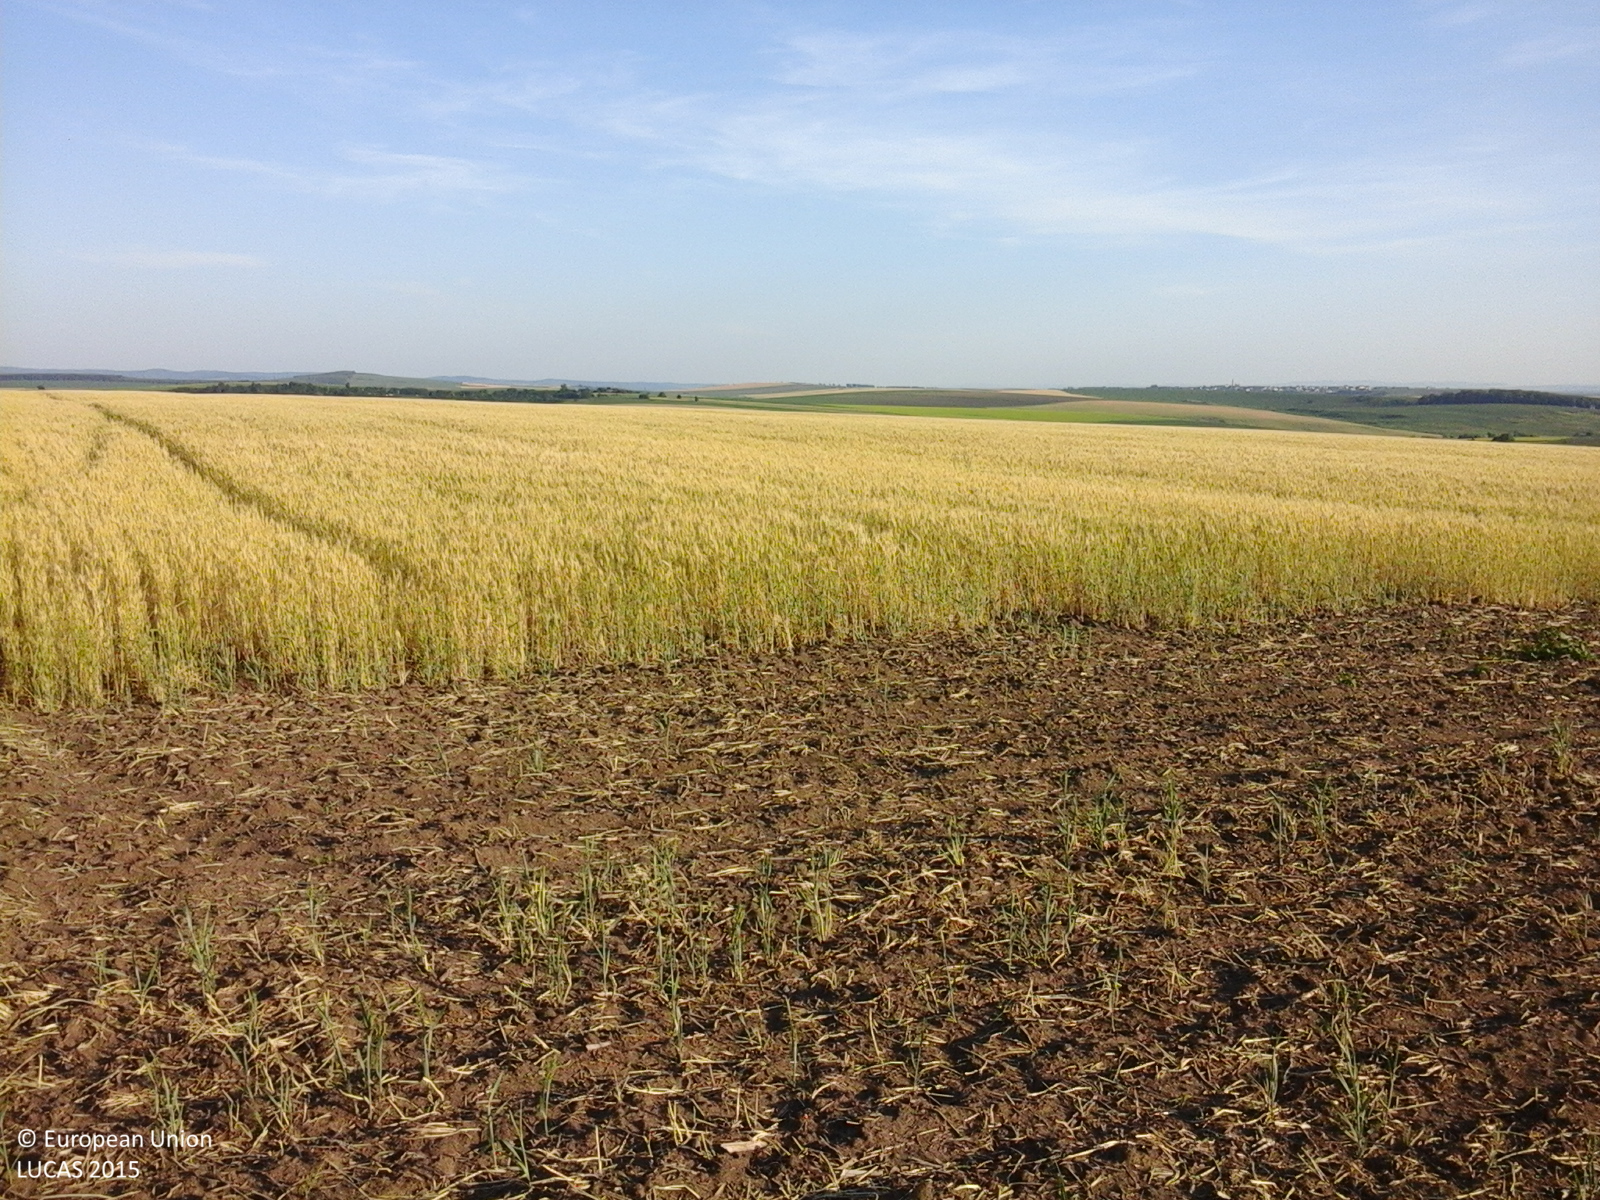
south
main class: Cropland
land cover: Common wheat
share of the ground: < 10 %
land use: Agriculture (excluding fallow land and kitchen gardens)
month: June
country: RO
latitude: 47.0961
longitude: 26.9765
